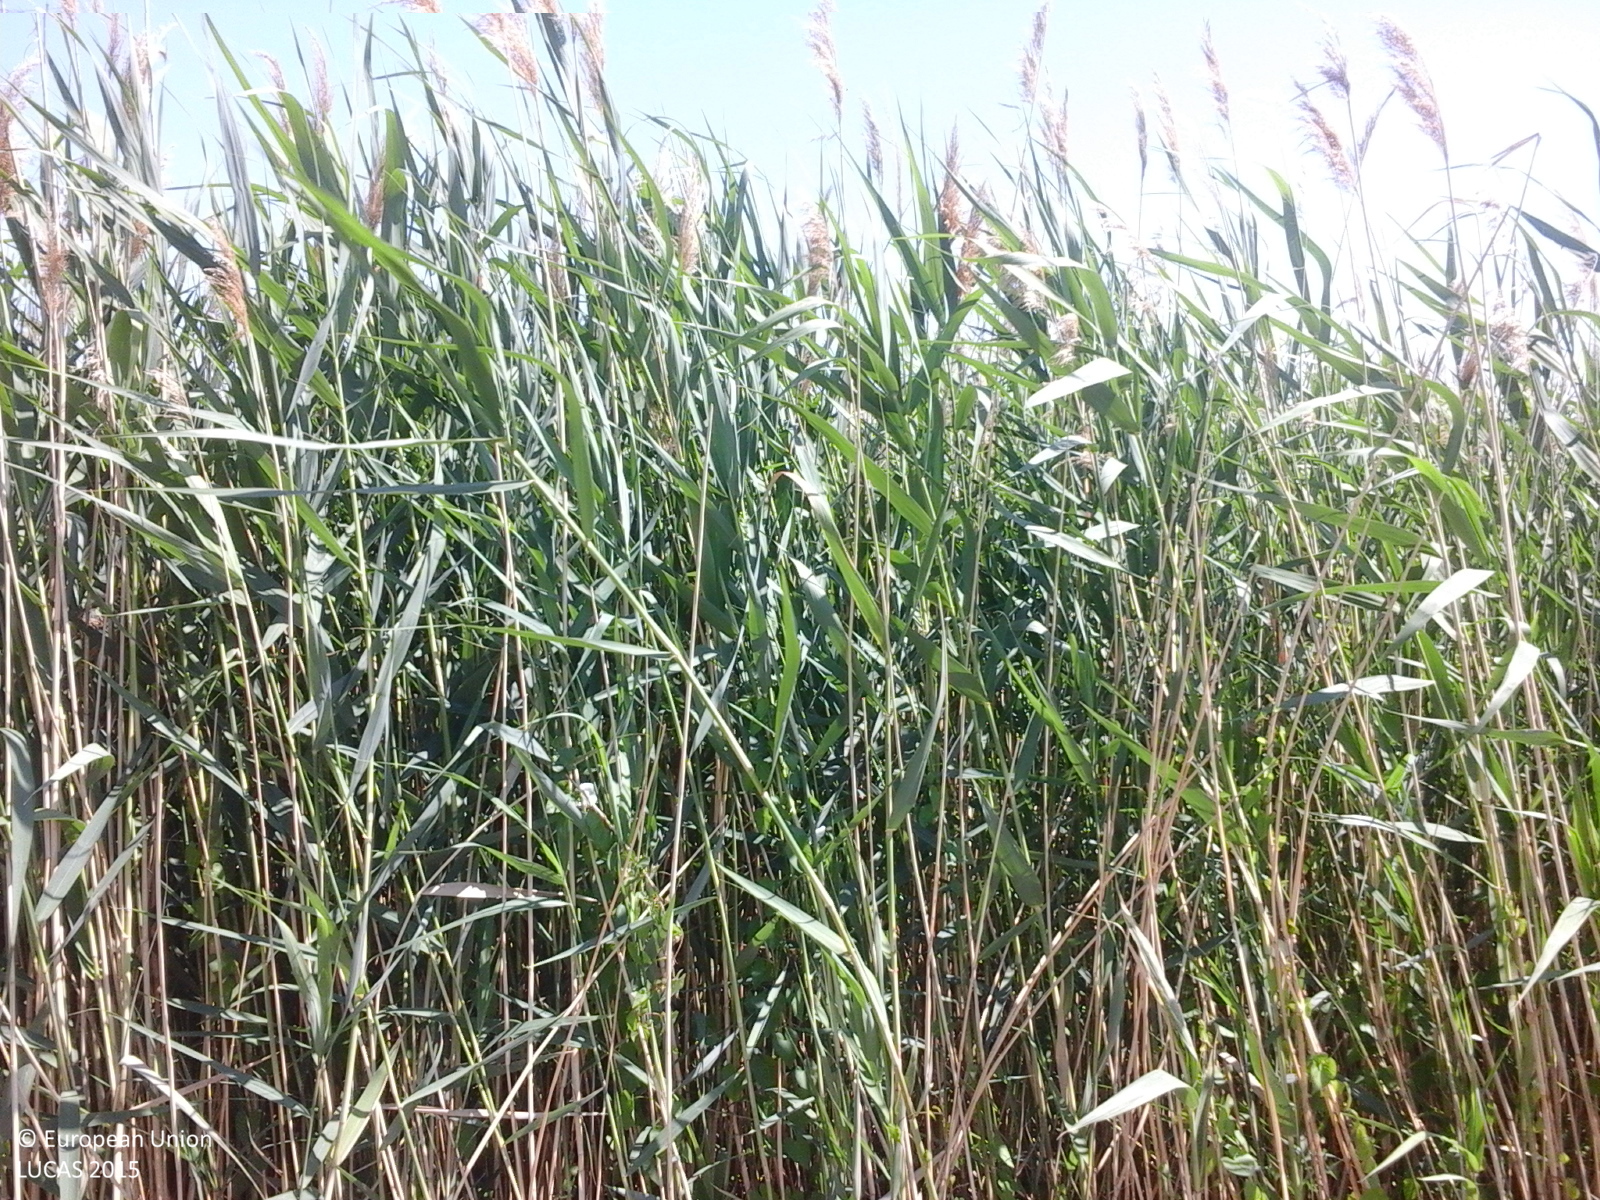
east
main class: Grassland
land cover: Grassland without tree/shrub cover
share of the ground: > 75 %
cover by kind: herbaceous plants 100 %
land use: Agriculture (excluding fallow land and kitchen gardens)
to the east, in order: Grassland without tree/shrub cover; Inland marshes; Grassland without tree/shrub cover; Common wheat
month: June
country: RO
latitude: 47.6546
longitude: 27.1646
